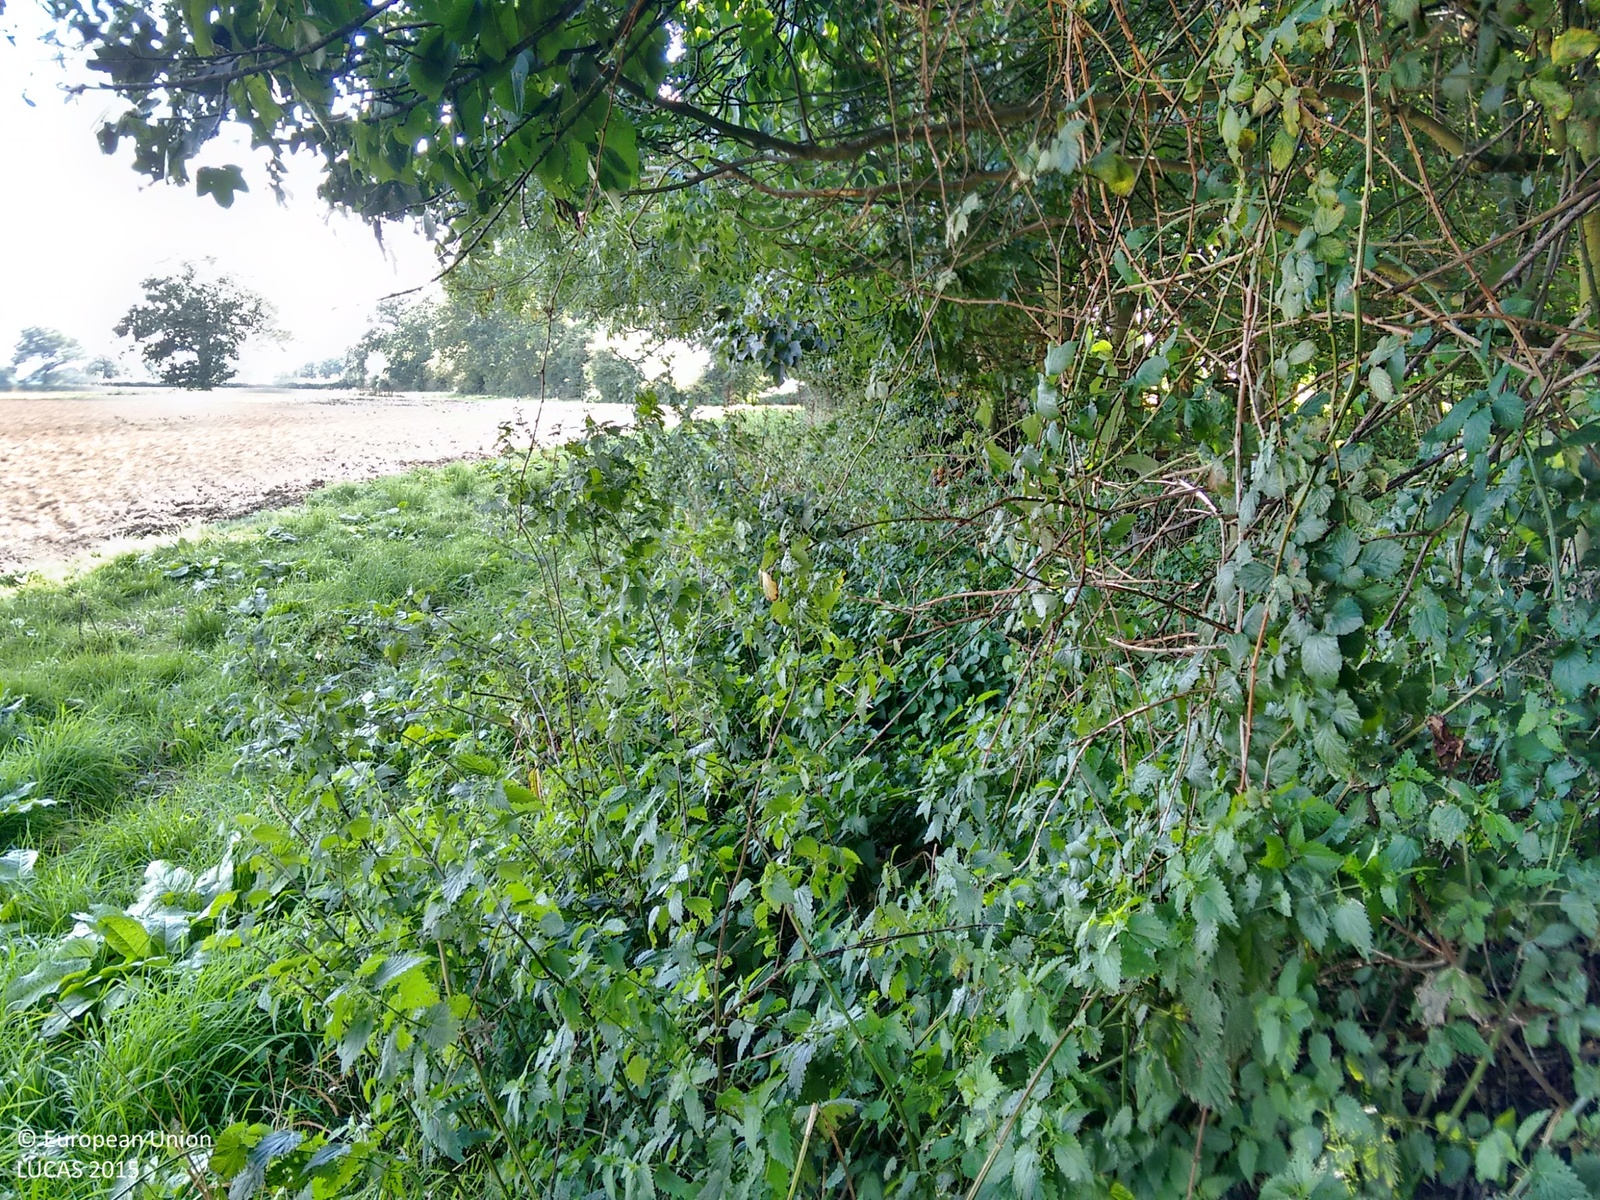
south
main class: Woodland
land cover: Broadleaved woodland
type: mesophytic deciduous forest
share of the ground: > 75 %
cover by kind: broadleaved forest trees 100 %
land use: Agriculture (excluding fallow land and kitchen gardens)
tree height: > 5 m
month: September
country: GB
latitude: 52.3677
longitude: 0.8552
